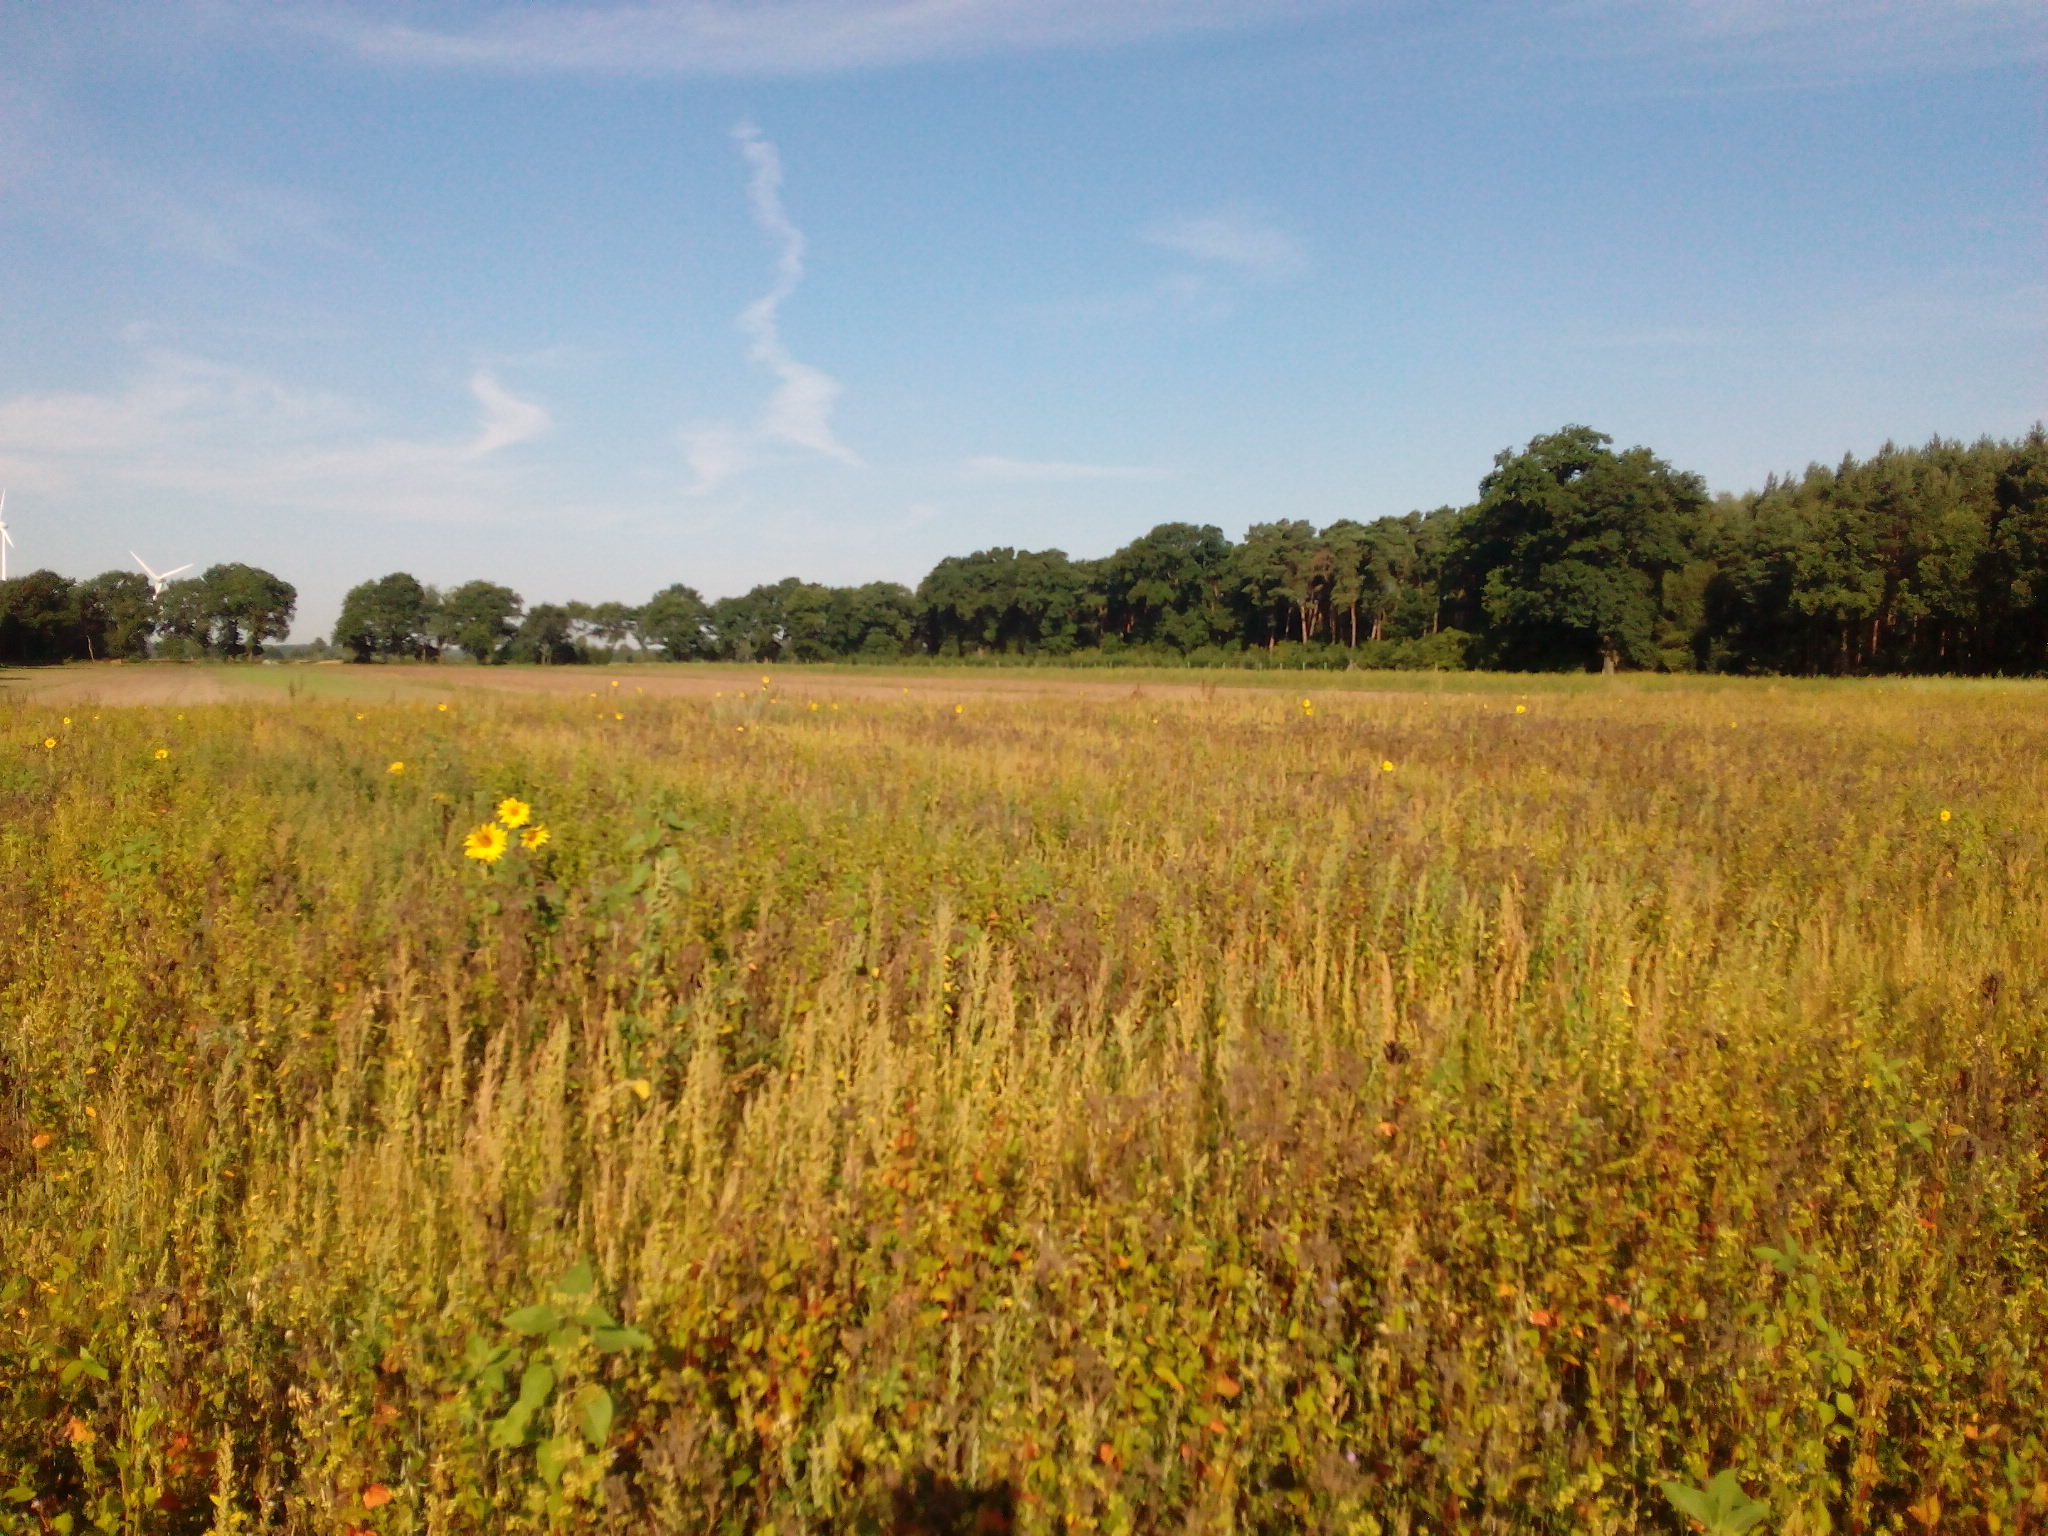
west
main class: Cropland
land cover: Lucerne
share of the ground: > 75 %
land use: Agriculture (excluding fallow land and kitchen gardens)
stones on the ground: < 10 %
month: August
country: DE
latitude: 52.5571
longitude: 9.8673
